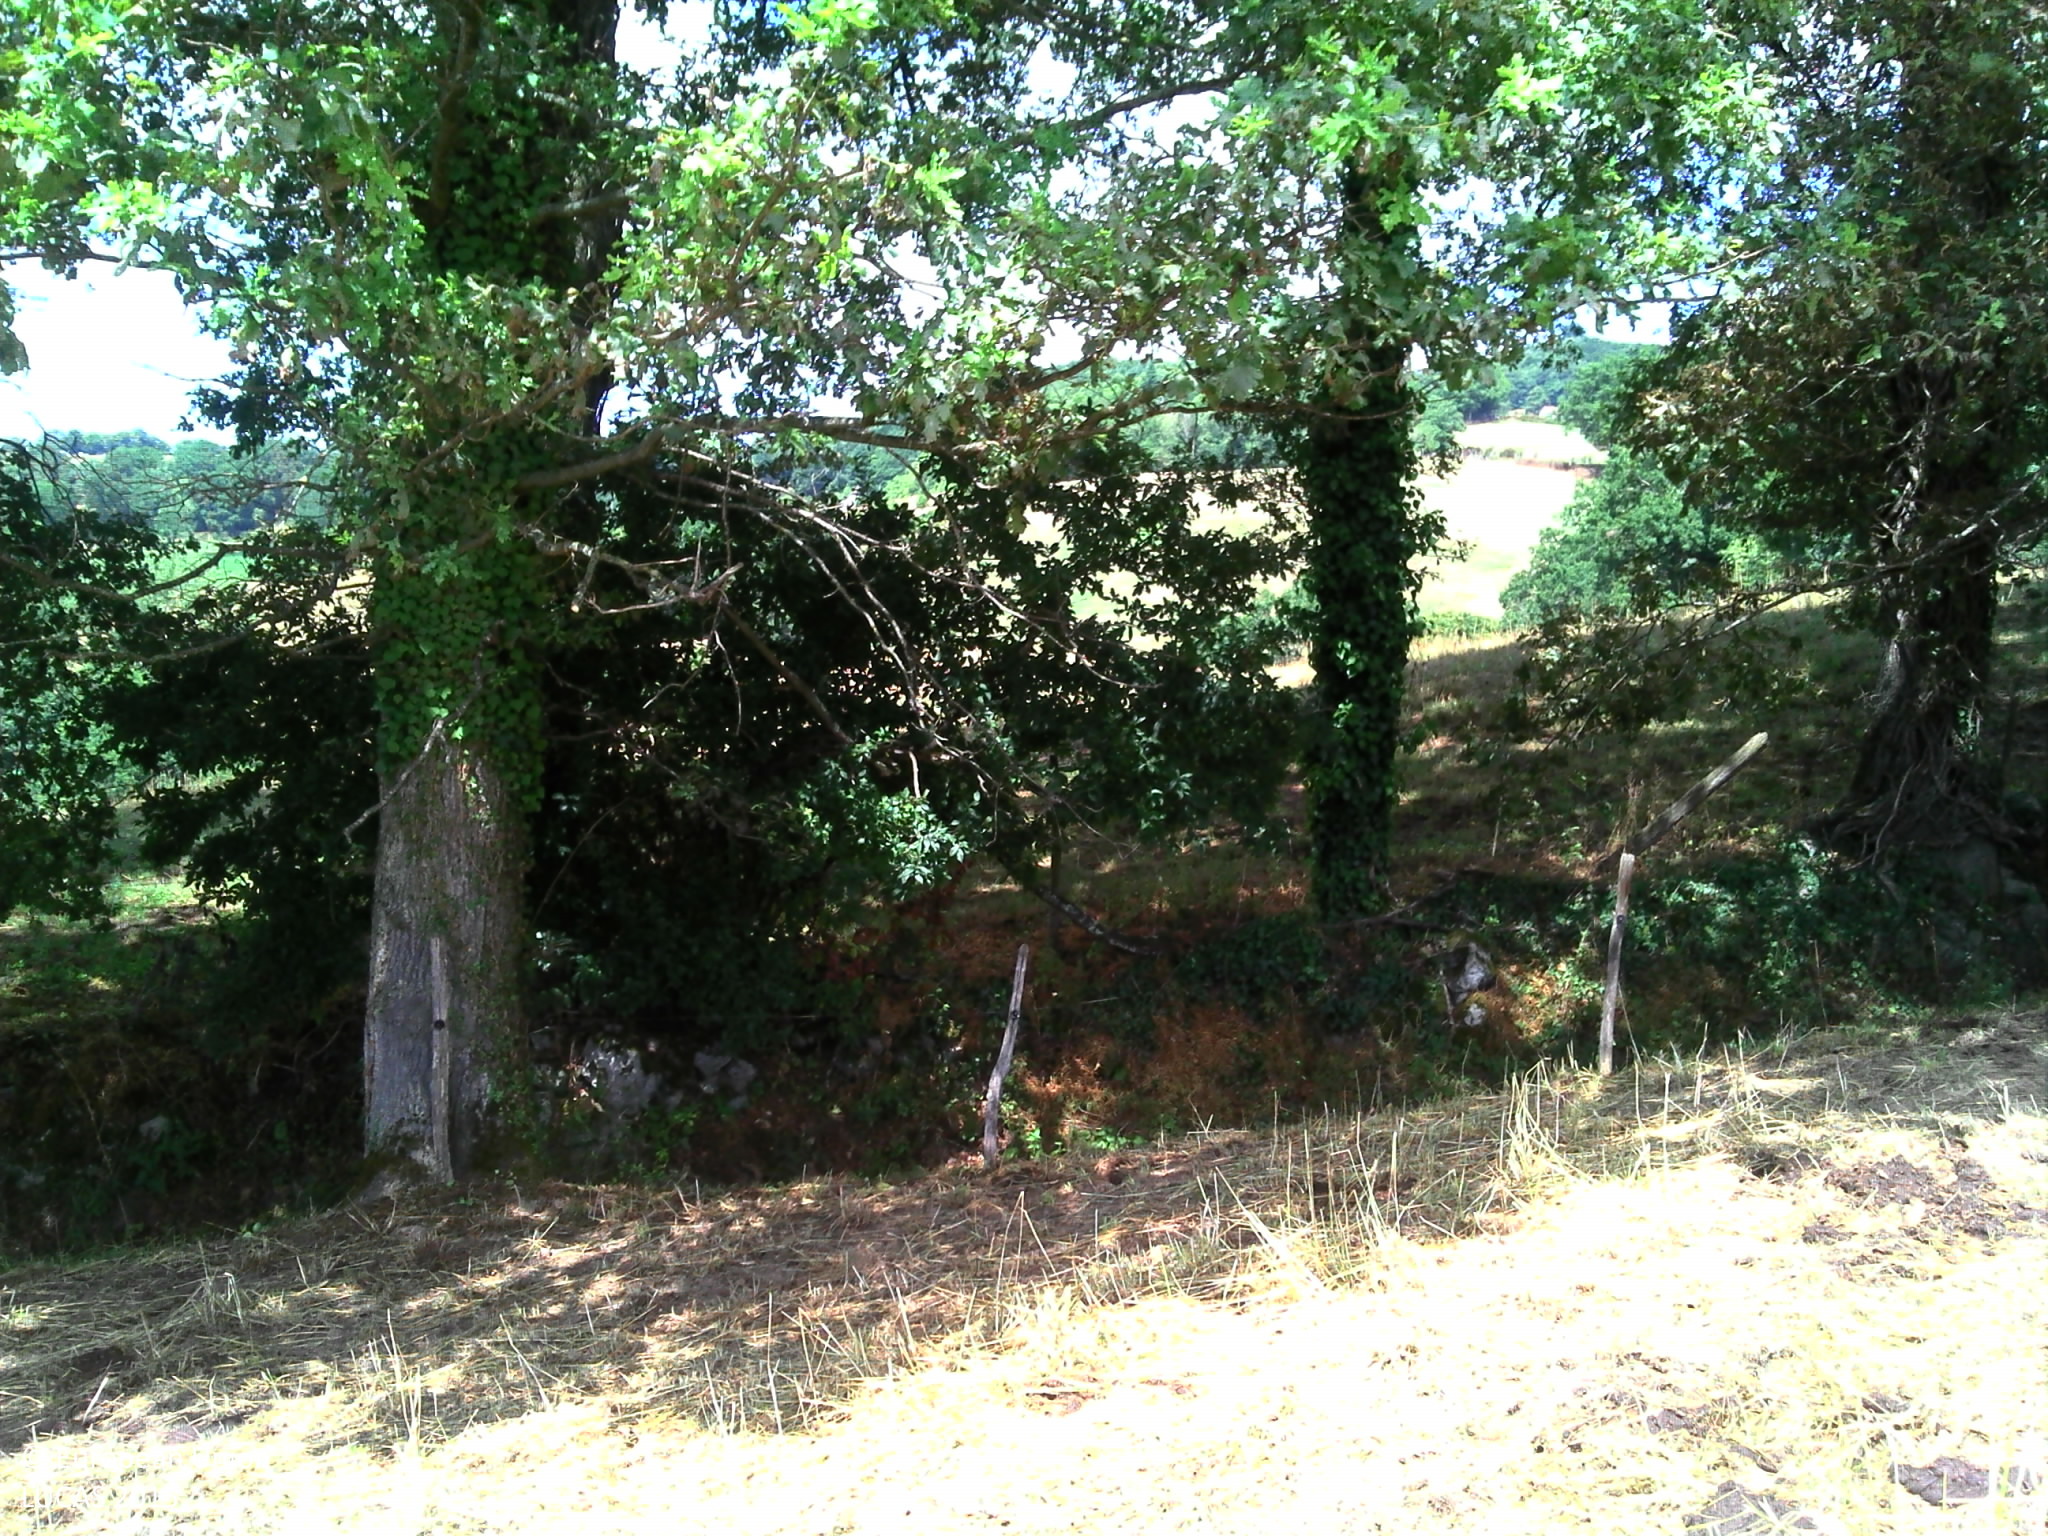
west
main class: Grassland
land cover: Grassland without tree/shrub cover
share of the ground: > 75 %
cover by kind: herbaceous plants 100 %
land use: Agriculture (excluding fallow land and kitchen gardens)
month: July
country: FR
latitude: 44.7065
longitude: 2.4157
